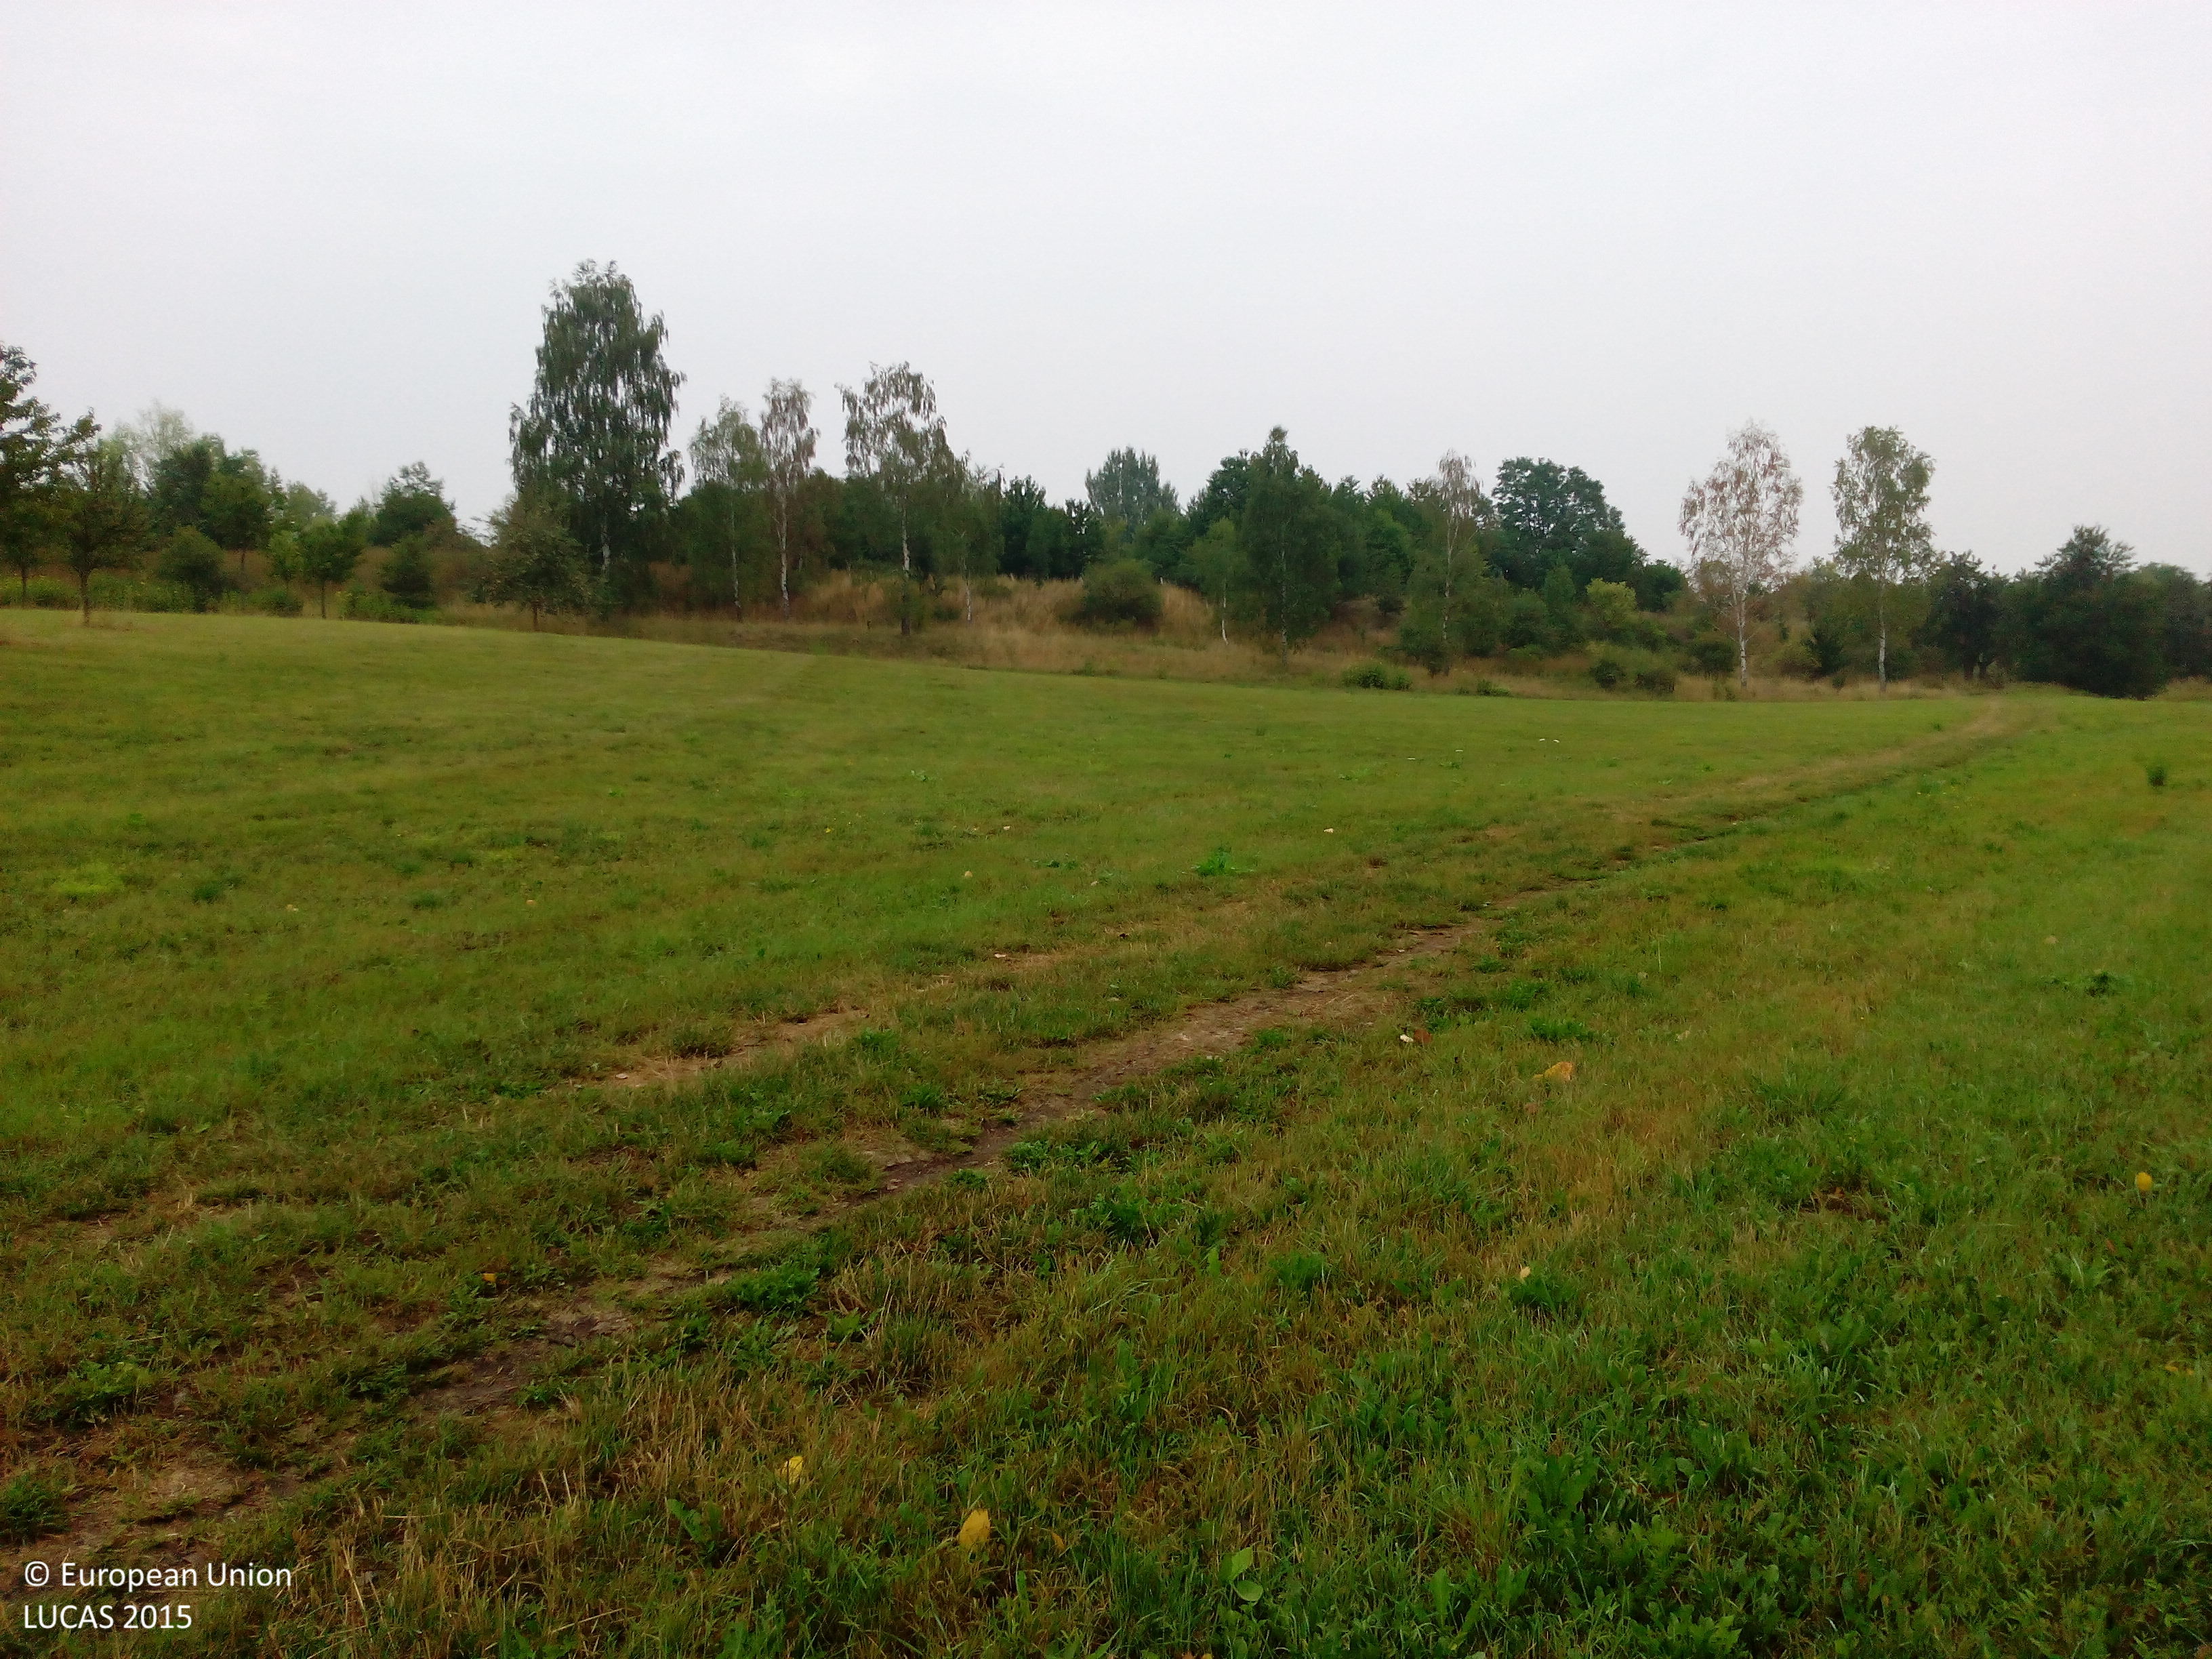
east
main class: Grassland
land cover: Grassland without tree/shrub cover
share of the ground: > 75 %
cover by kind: herbaceous plants 100 %
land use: Agriculture (excluding fallow land and kitchen gardens)
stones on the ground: 10 - 25 %
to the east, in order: Grassland without tree/shrub cover; Tracks; Grassland without tree/shrub cover; Tracks; Grassland without tree/shrub cover; Broadleaved woodland; Tracks; Shruby margins; Fences; Cherry fruit; Fences; Grassland without tree/shrub cover; Rape and turnip rape
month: August
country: DE
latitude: 50.9184
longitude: 10.8390
